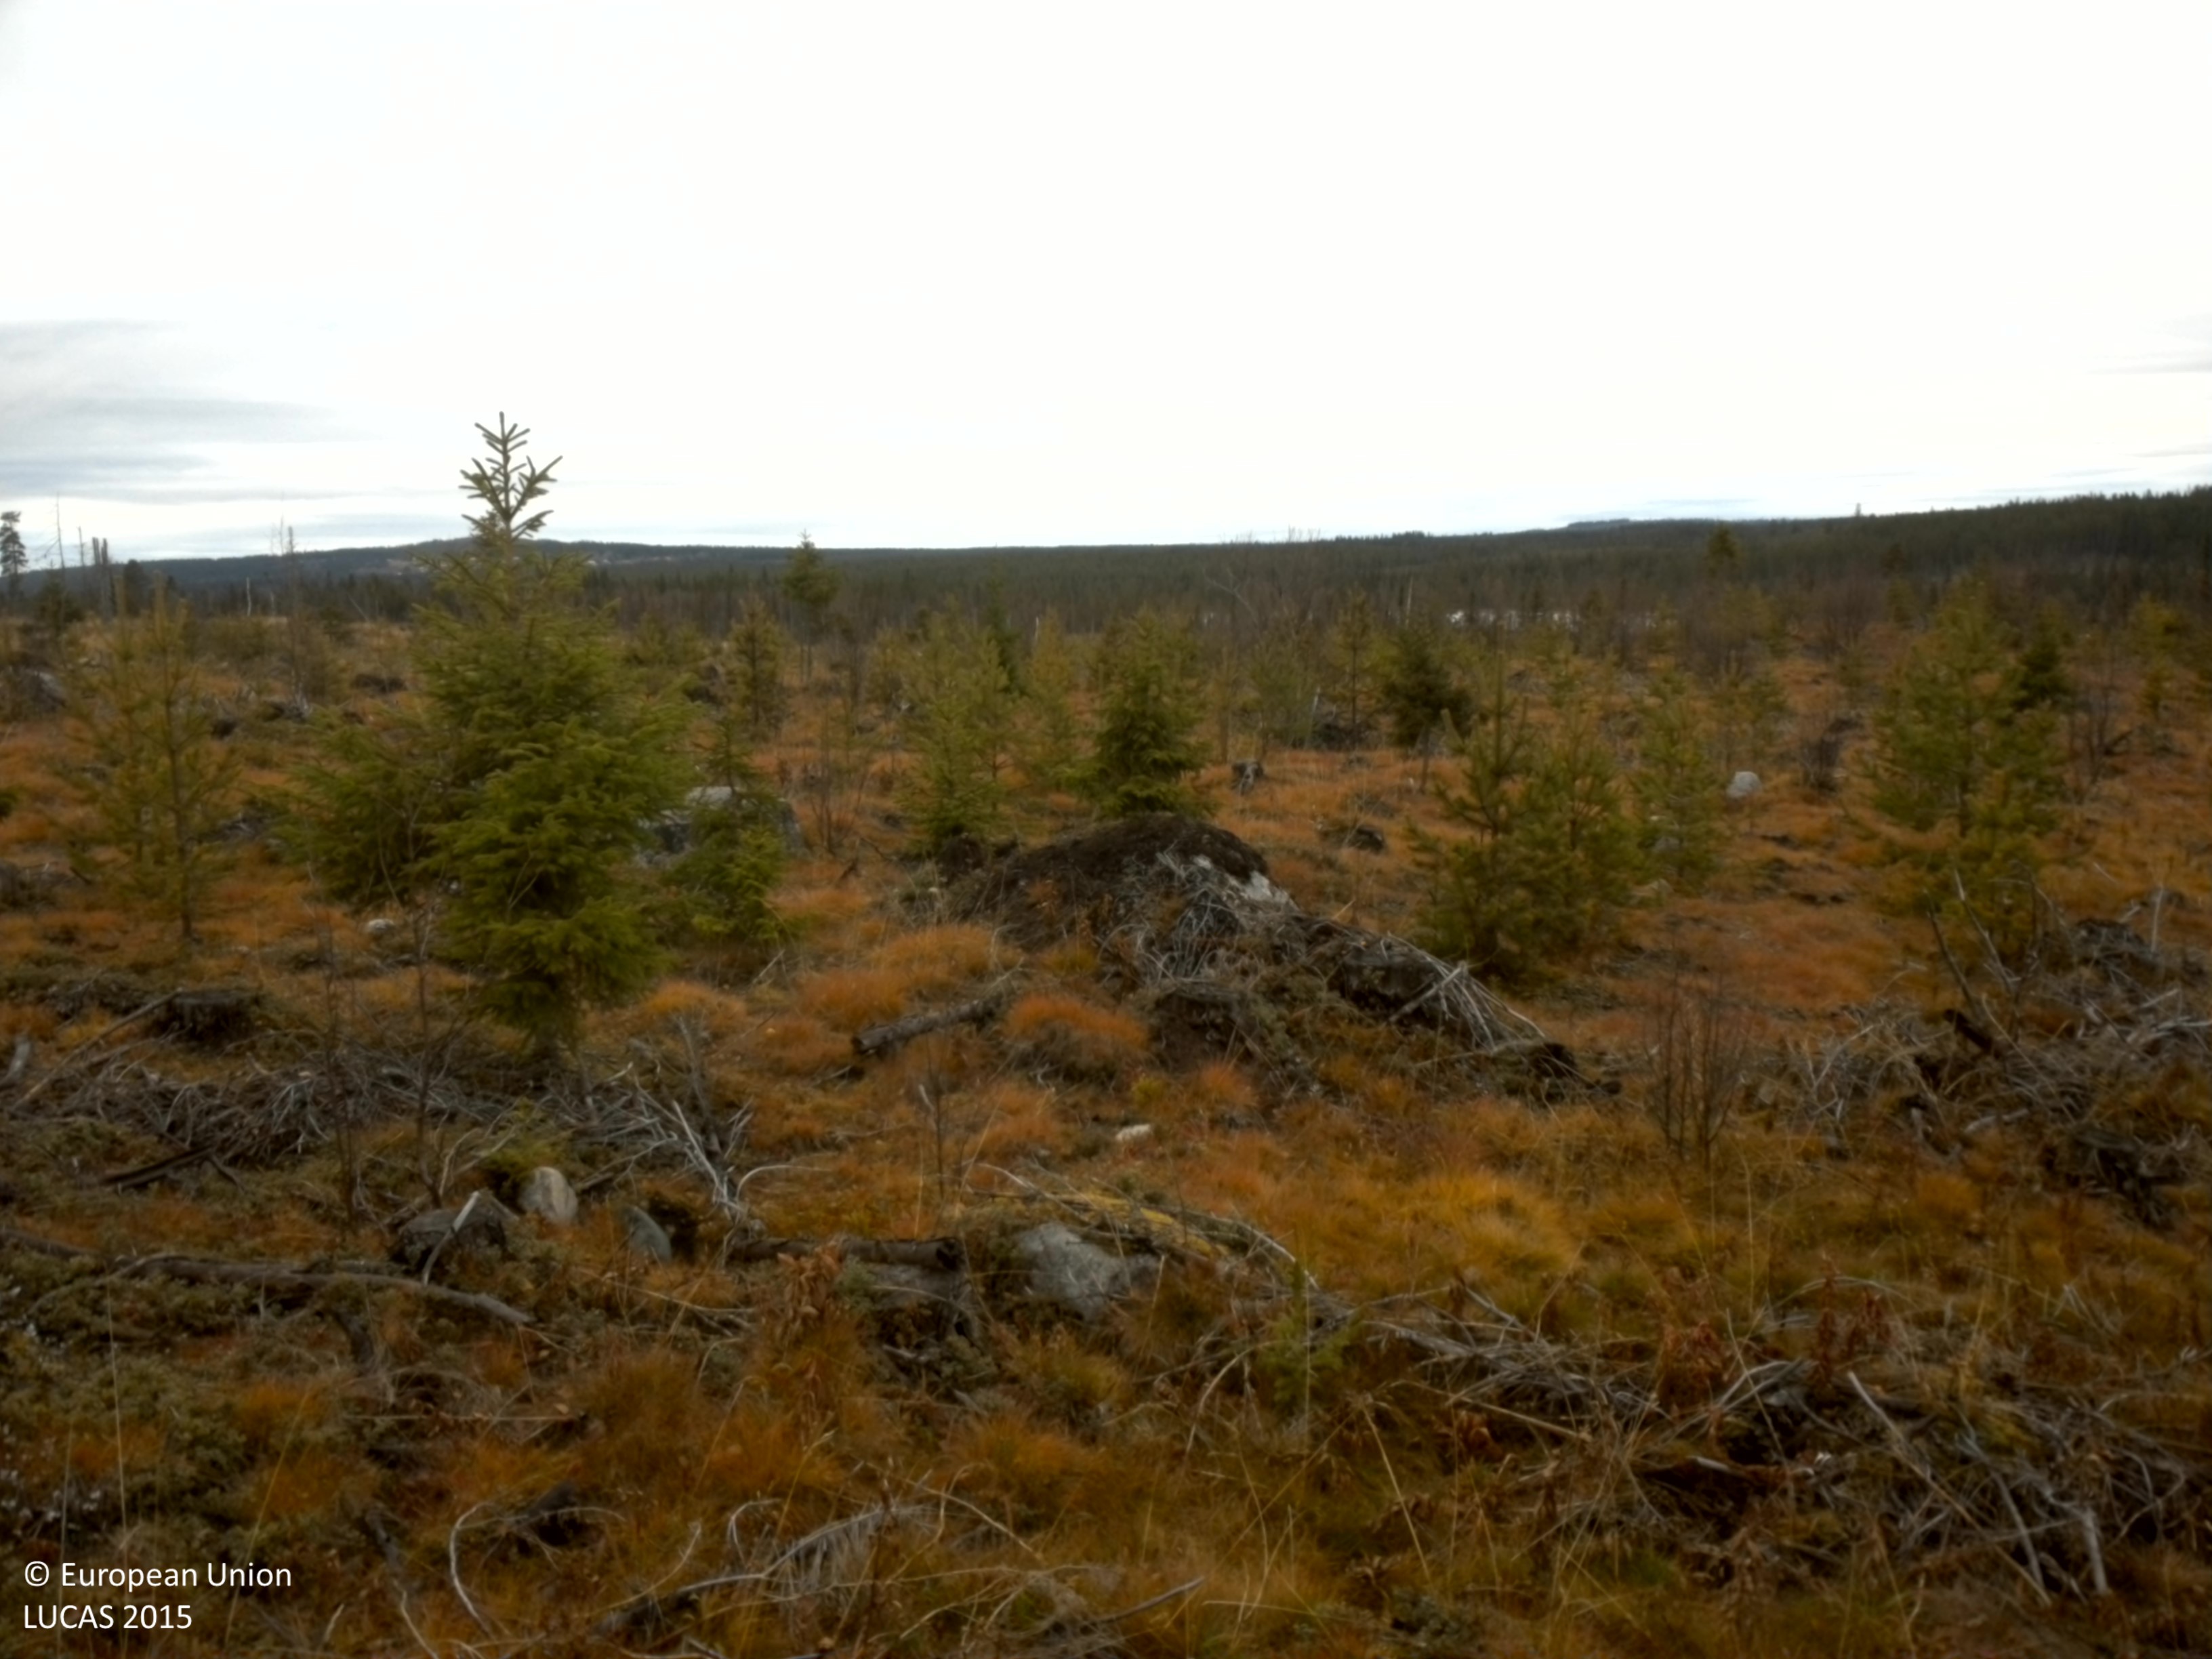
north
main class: Woodland
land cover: Pine dominated mixed woodland
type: boreal forest
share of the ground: 10 - 25 %
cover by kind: herbaceous plants 50 %, shrubs 20 %, lichens and mosses 20 %, coniferous forest trees 5 %, broadleaved forest trees 5 %
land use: Forestry
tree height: < 5 m
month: October
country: SE
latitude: 64.5157
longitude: 17.4035
